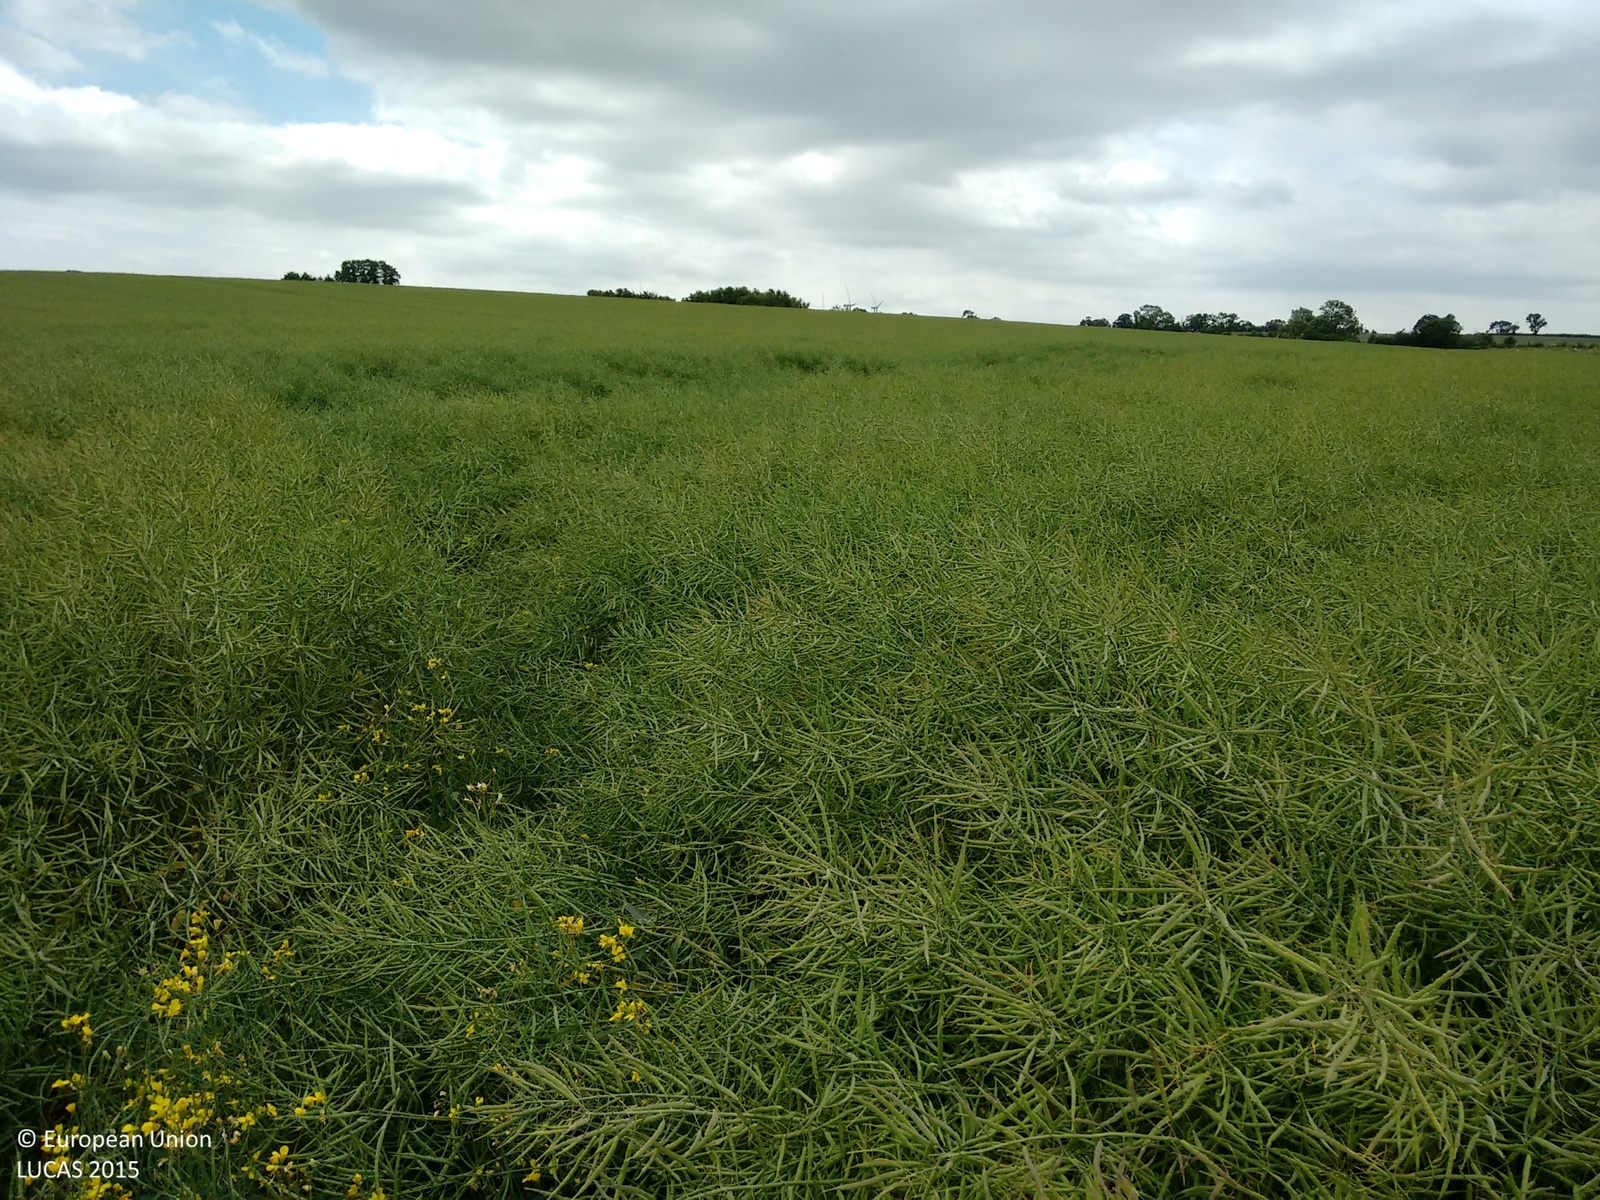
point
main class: Cropland
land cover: Rape and turnip rape
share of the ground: > 75 %
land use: Agriculture (excluding fallow land and kitchen gardens)
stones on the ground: < 10 %
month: June
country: GB
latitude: 52.1495
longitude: -0.6651
